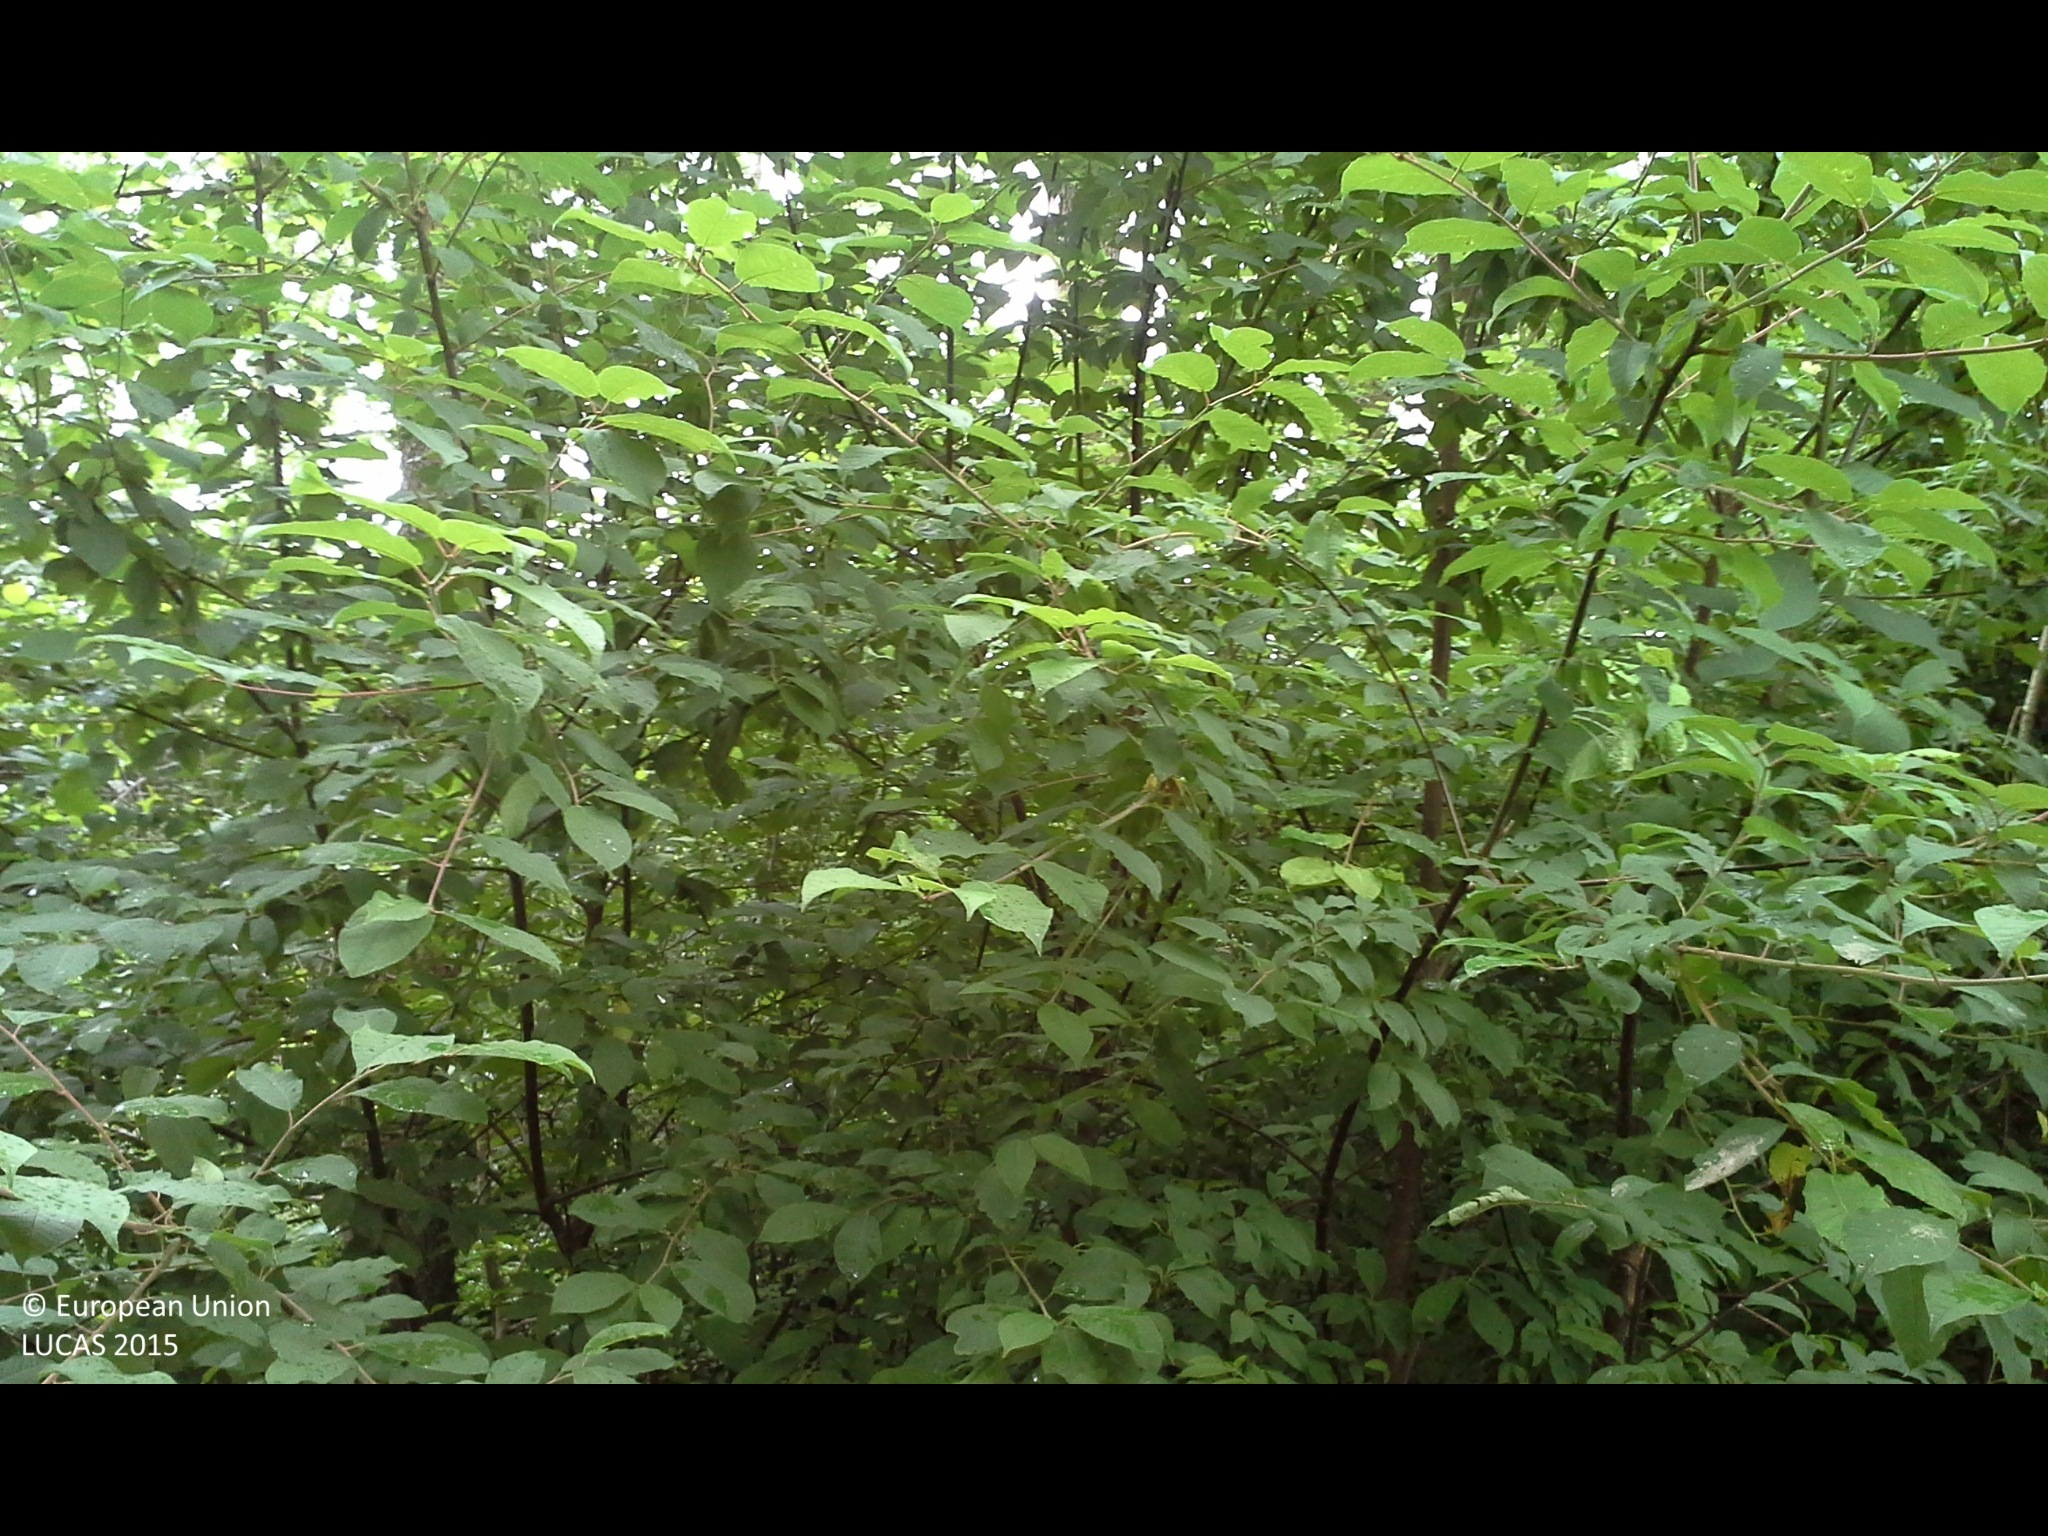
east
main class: Woodland
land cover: Broadleaved woodland
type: floodplain forest
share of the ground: > 75 %
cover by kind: broadleaved forest trees 80 %, shrubs 20 %
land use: Forestry
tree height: > 5 m
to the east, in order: Broadleaved woodland; Maize; Tracks; Maize
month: May
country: AT
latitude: 48.1602
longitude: 14.2348
